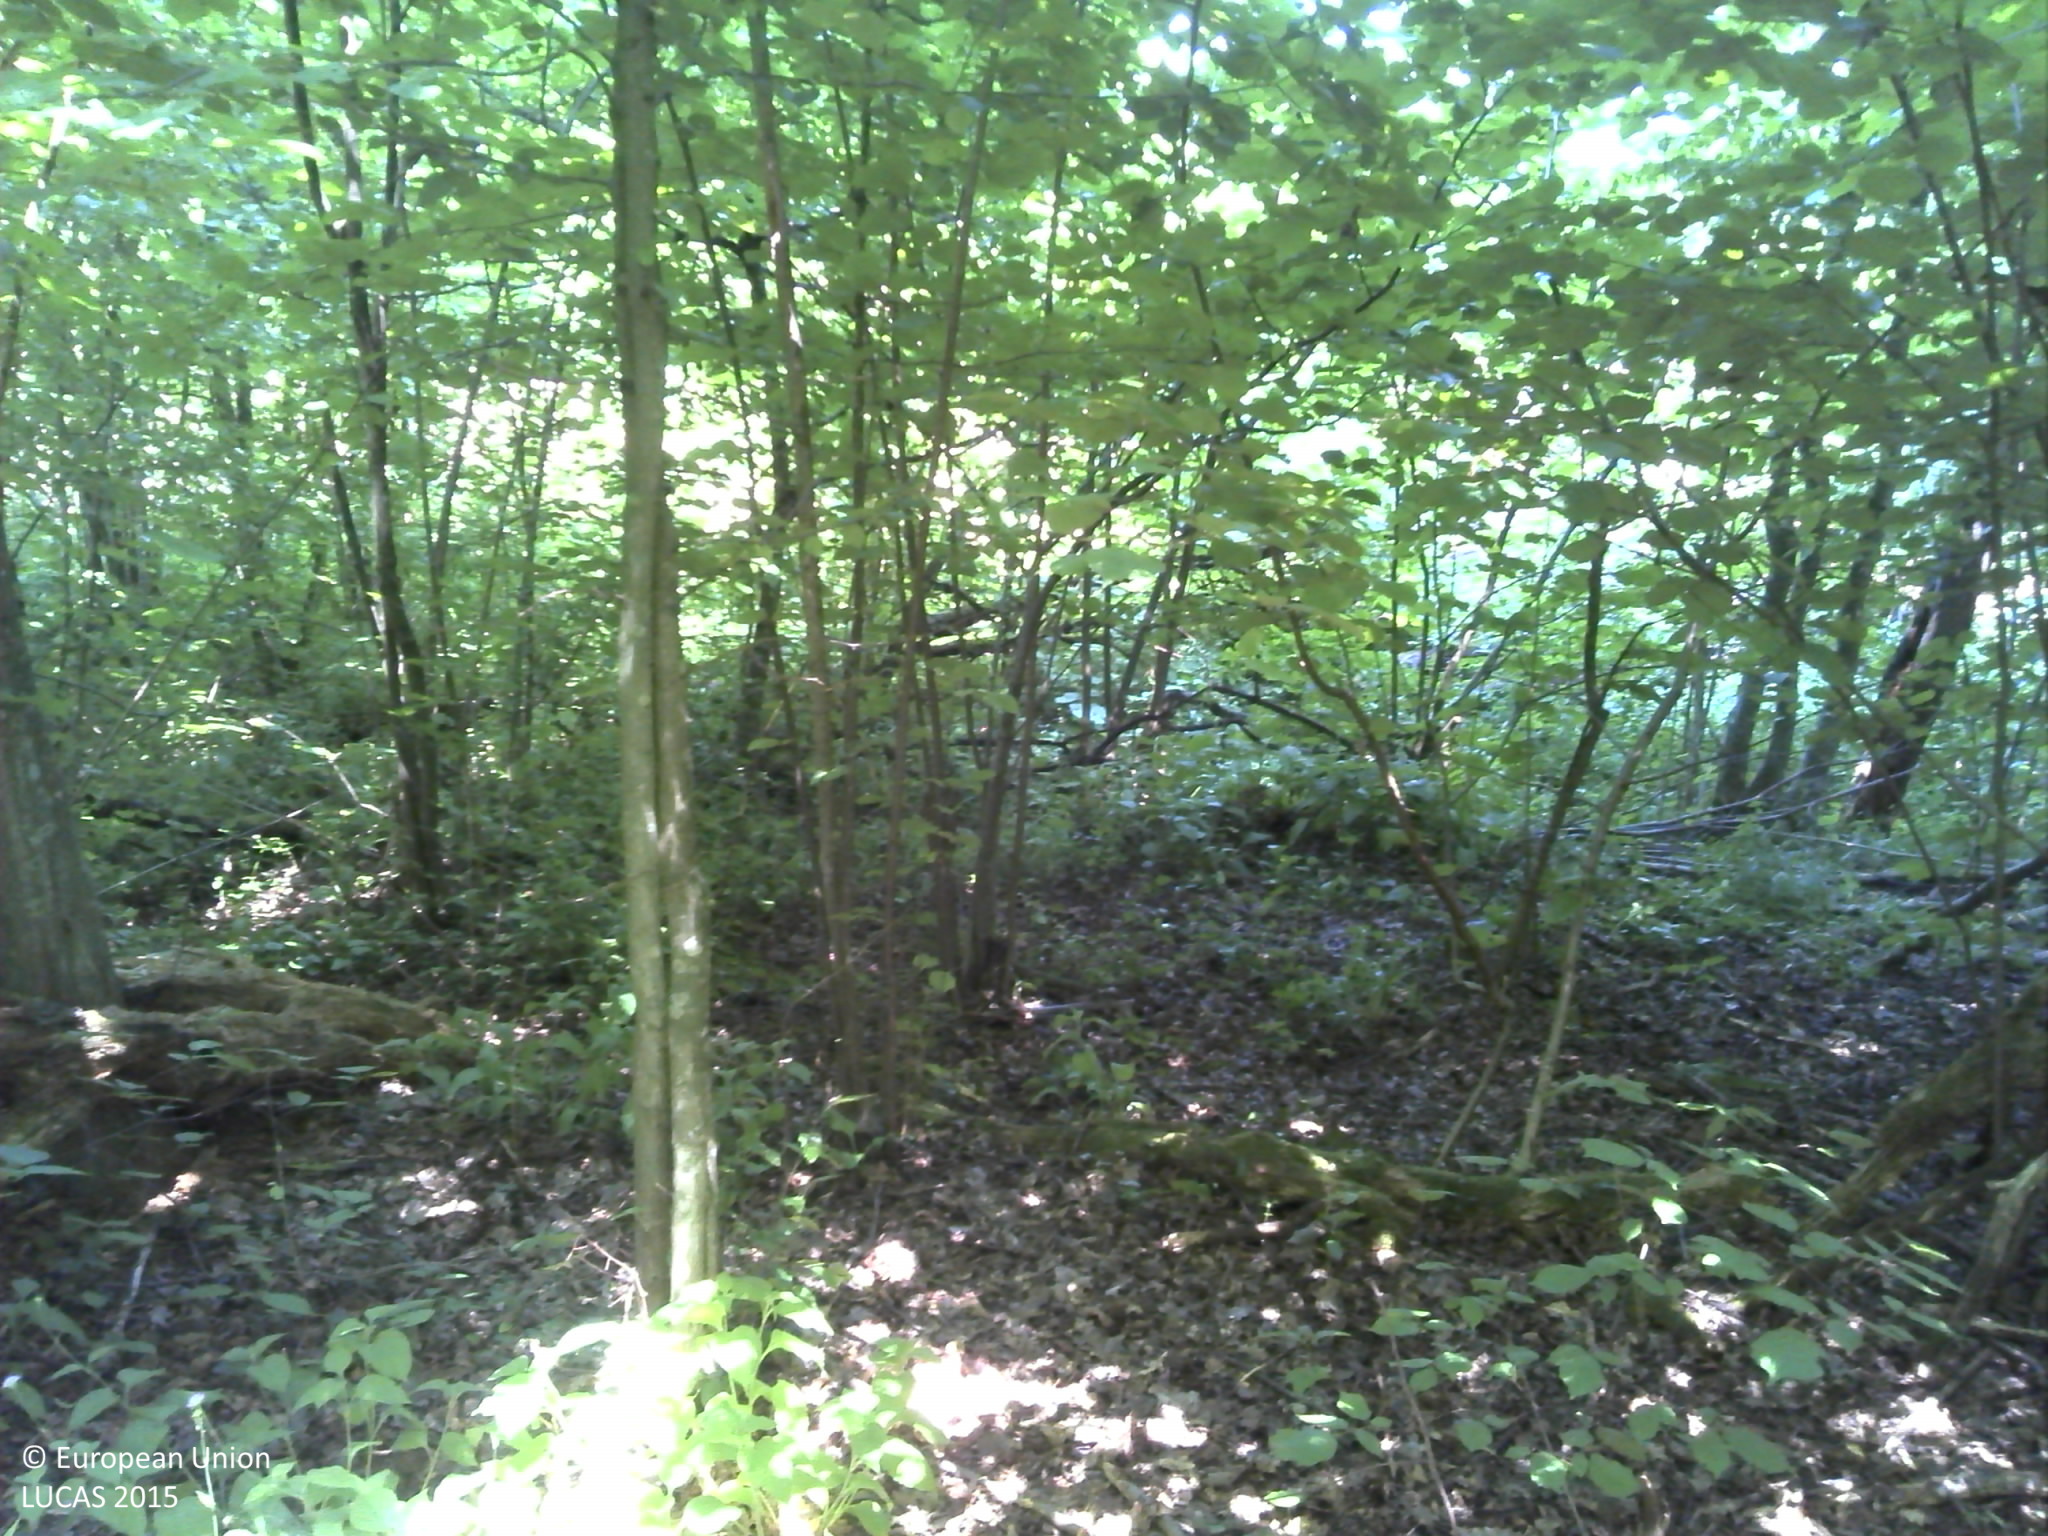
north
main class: Woodland
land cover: Broadleaved woodland
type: acidophilous oak and oak-birch forest
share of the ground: > 75 %
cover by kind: broadleaved forest trees 90 %, shrubs 5 %, herbaceous plants 5 %
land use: Forestry
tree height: > 5 m
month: July
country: HR
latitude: 45.7421
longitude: 16.7216
